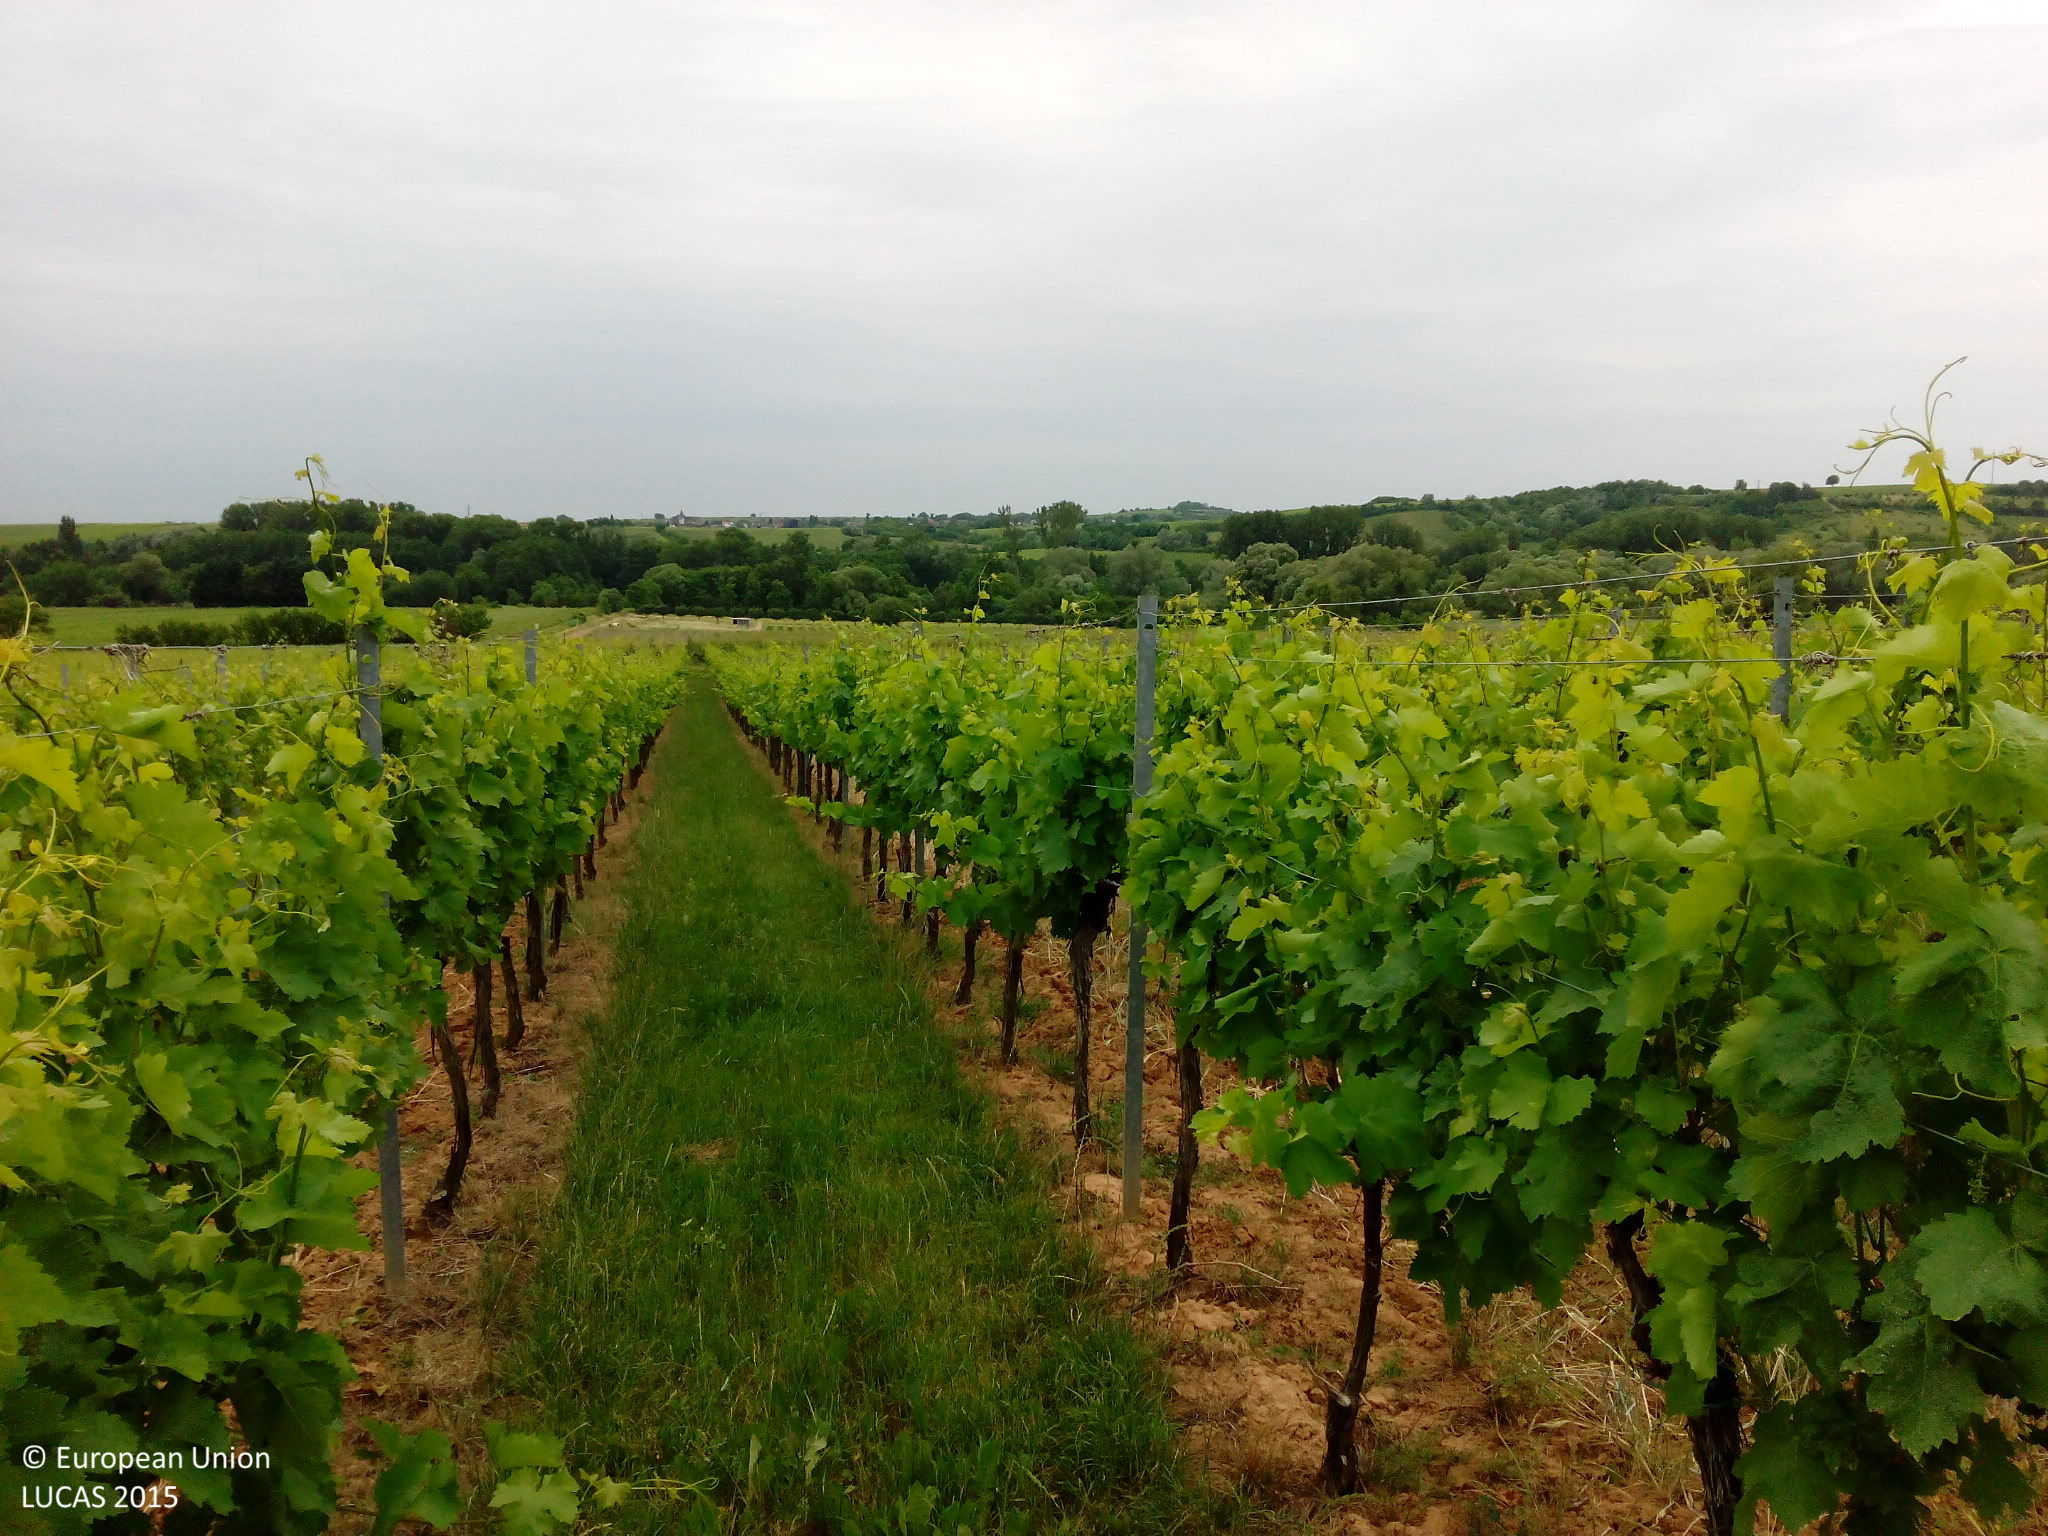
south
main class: Cropland
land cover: Vineyards
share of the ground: 10 - 25 %
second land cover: Grassland without tree/shrub cover
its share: 25 - 50 %
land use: Agriculture (excluding fallow land and kitchen gardens)
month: June
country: DE
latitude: 49.2144
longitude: 8.0649
